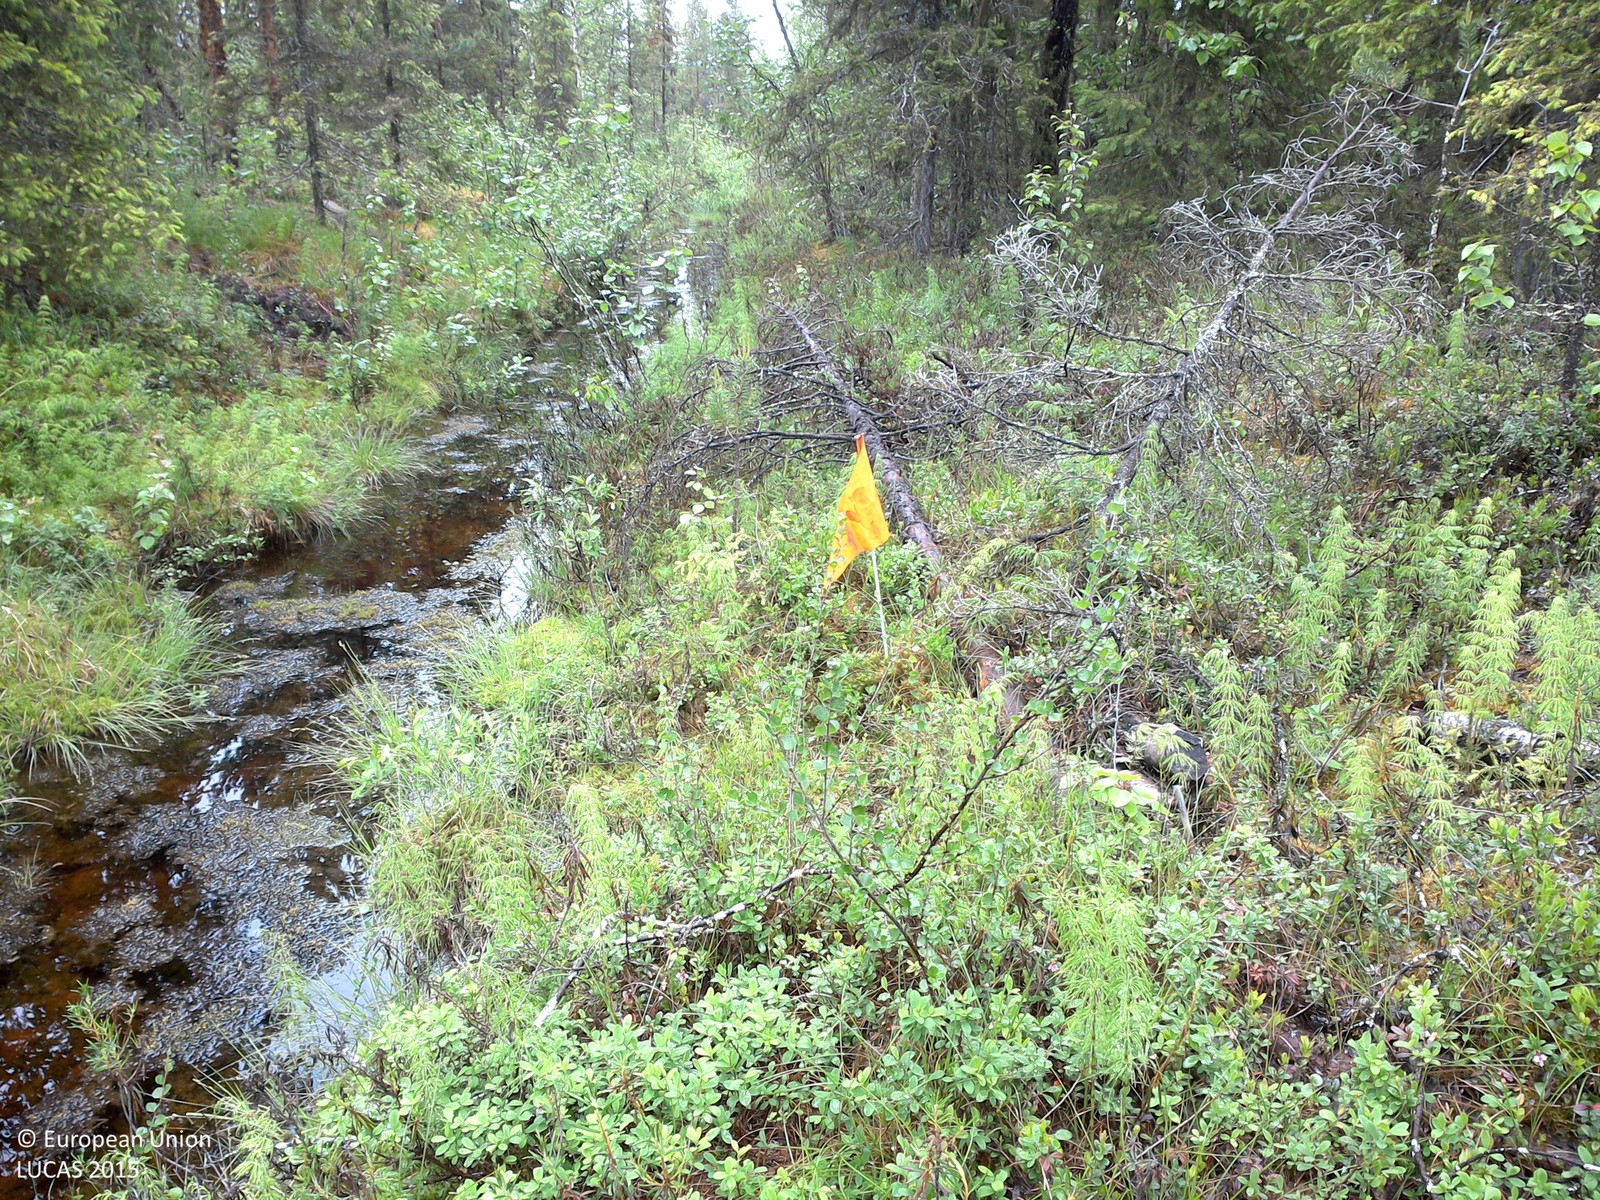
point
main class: Woodland
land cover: Pine dominated mixed woodland
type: boreal forest
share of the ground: 25 - 50 %
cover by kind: shrubs 55 %, coniferous forest trees 20 %, broadleaved forest trees 10 %, herbaceous plants 10 %, lichens and mosses 5 %
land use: Forestry
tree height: > 5 m
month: July
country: SE
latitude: 67.1029
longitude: 23.6350
